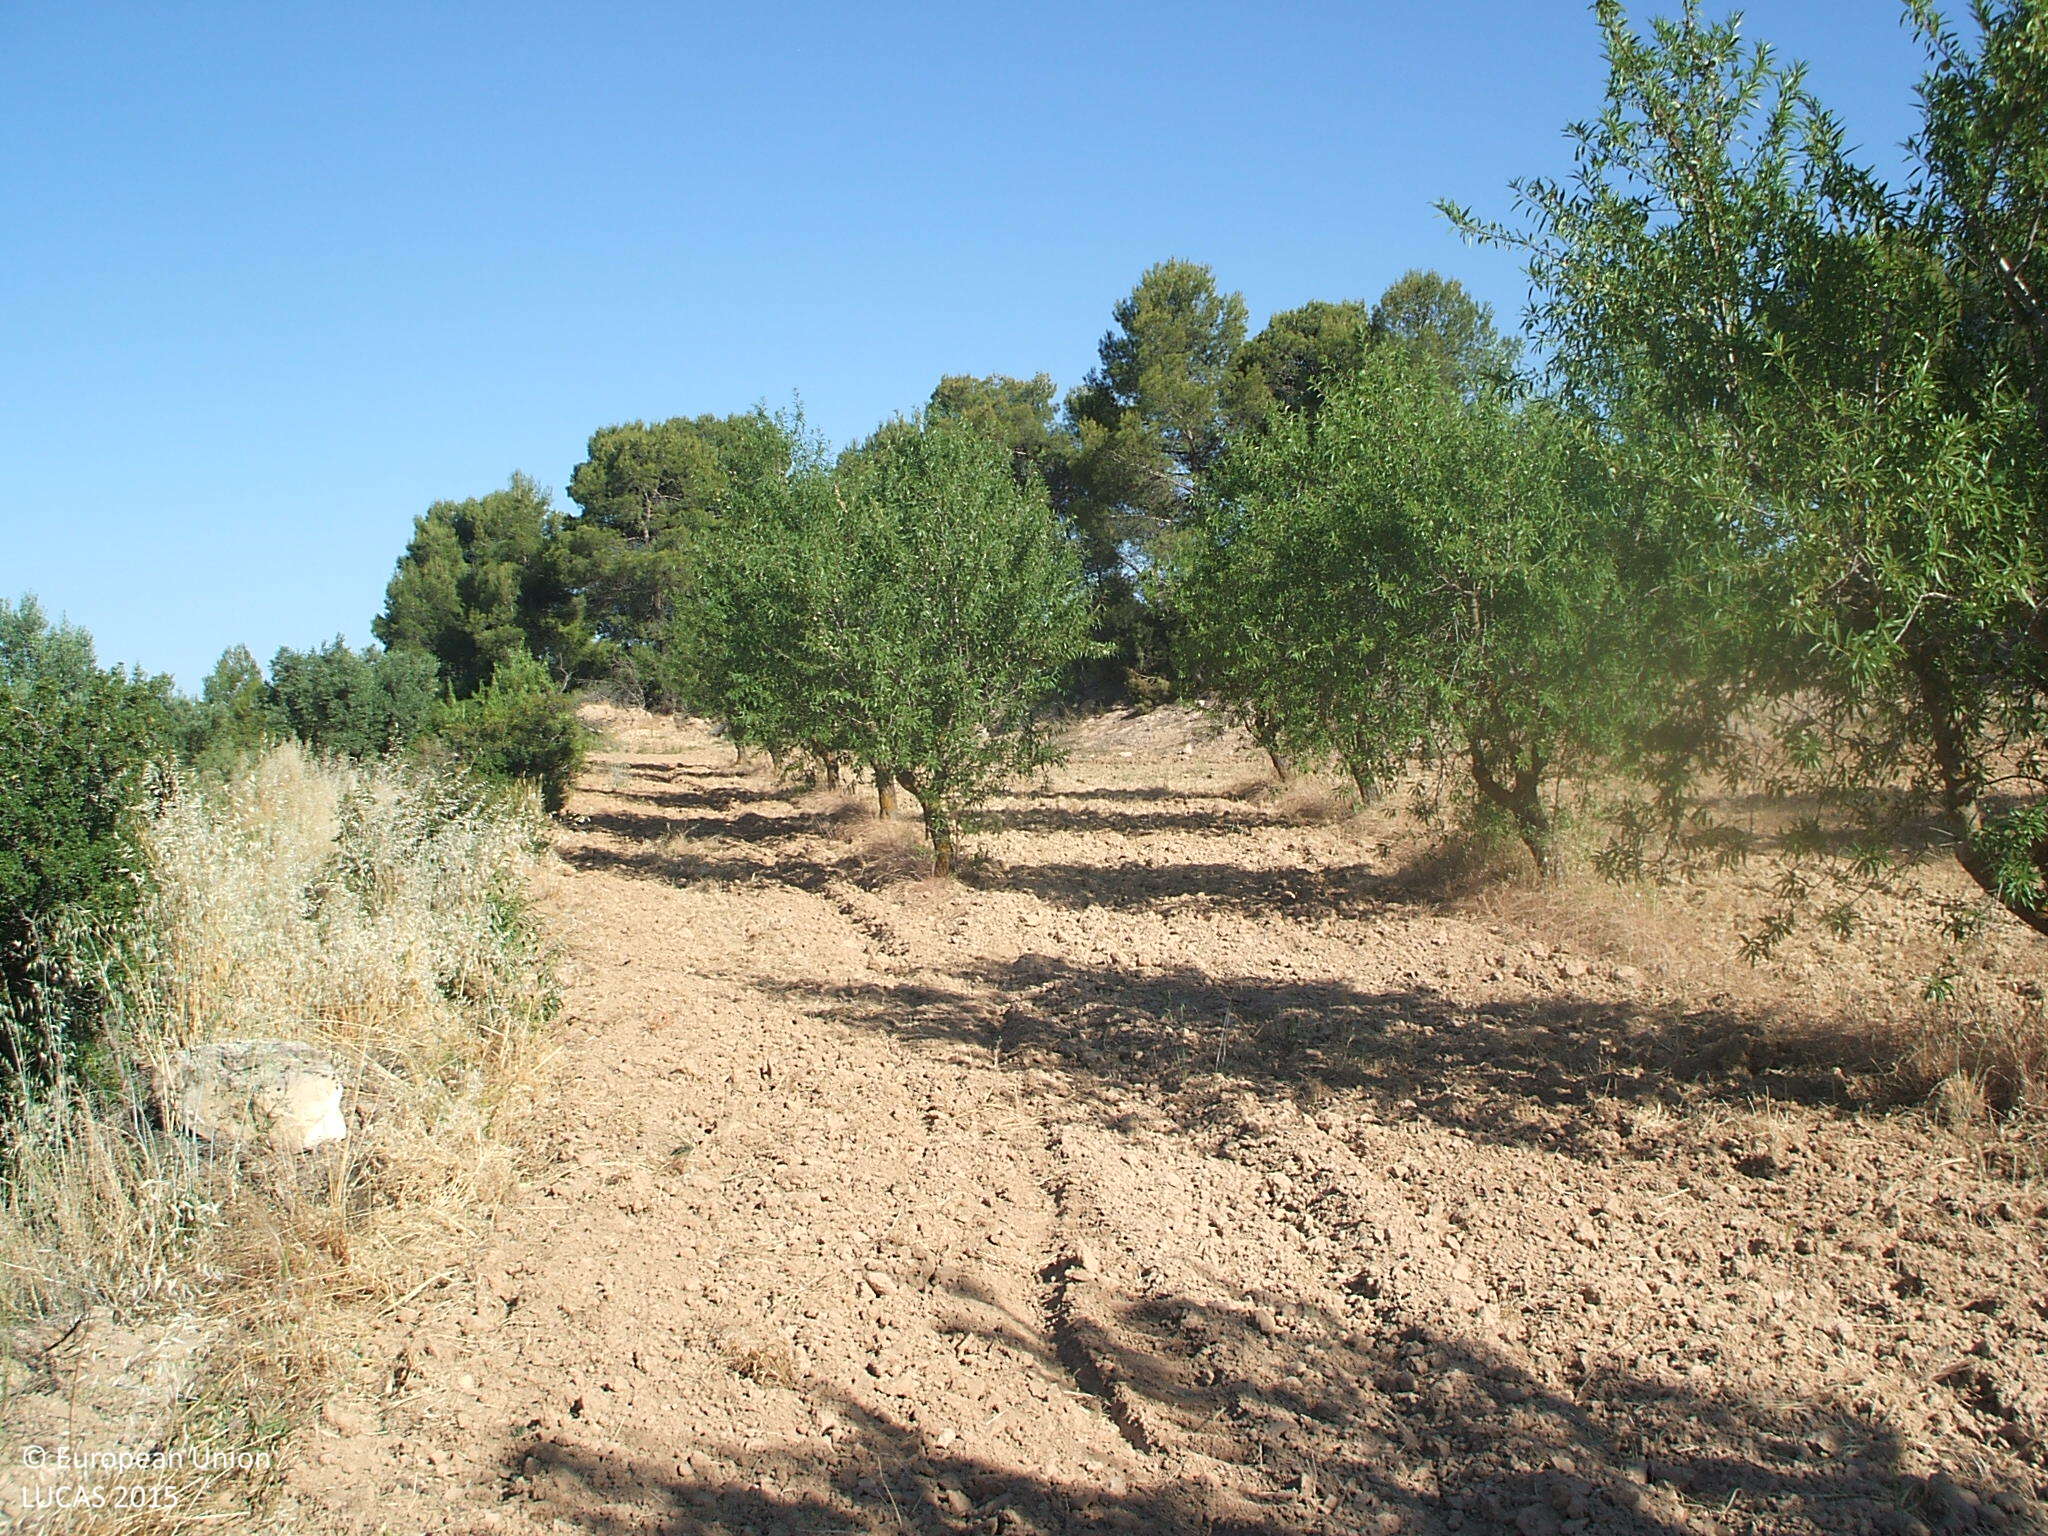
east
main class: Shrubland
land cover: Shrubland without tree cover
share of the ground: > 75 %
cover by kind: shrubs 100 %
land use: Agriculture (excluding fallow land and kitchen gardens)
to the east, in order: Shrubland without tree cover; Shrubland with sparse tree cover; Tracks; Nuts trees; Shruby margins; Dry stone walls; Grass margins; Nuts trees; Grass margins; Dry stone walls; Grass margins; Nuts trees; Grass margins; Tracks; Shruby margins; Dry stone walls; Shruby margins; Olive groves; Dry stone walls; Grass margins; Olive groves; Grass margins; Dry stone walls; Grass margins; Olive groves
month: June
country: ES
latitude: 41.0296
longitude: 0.1780
